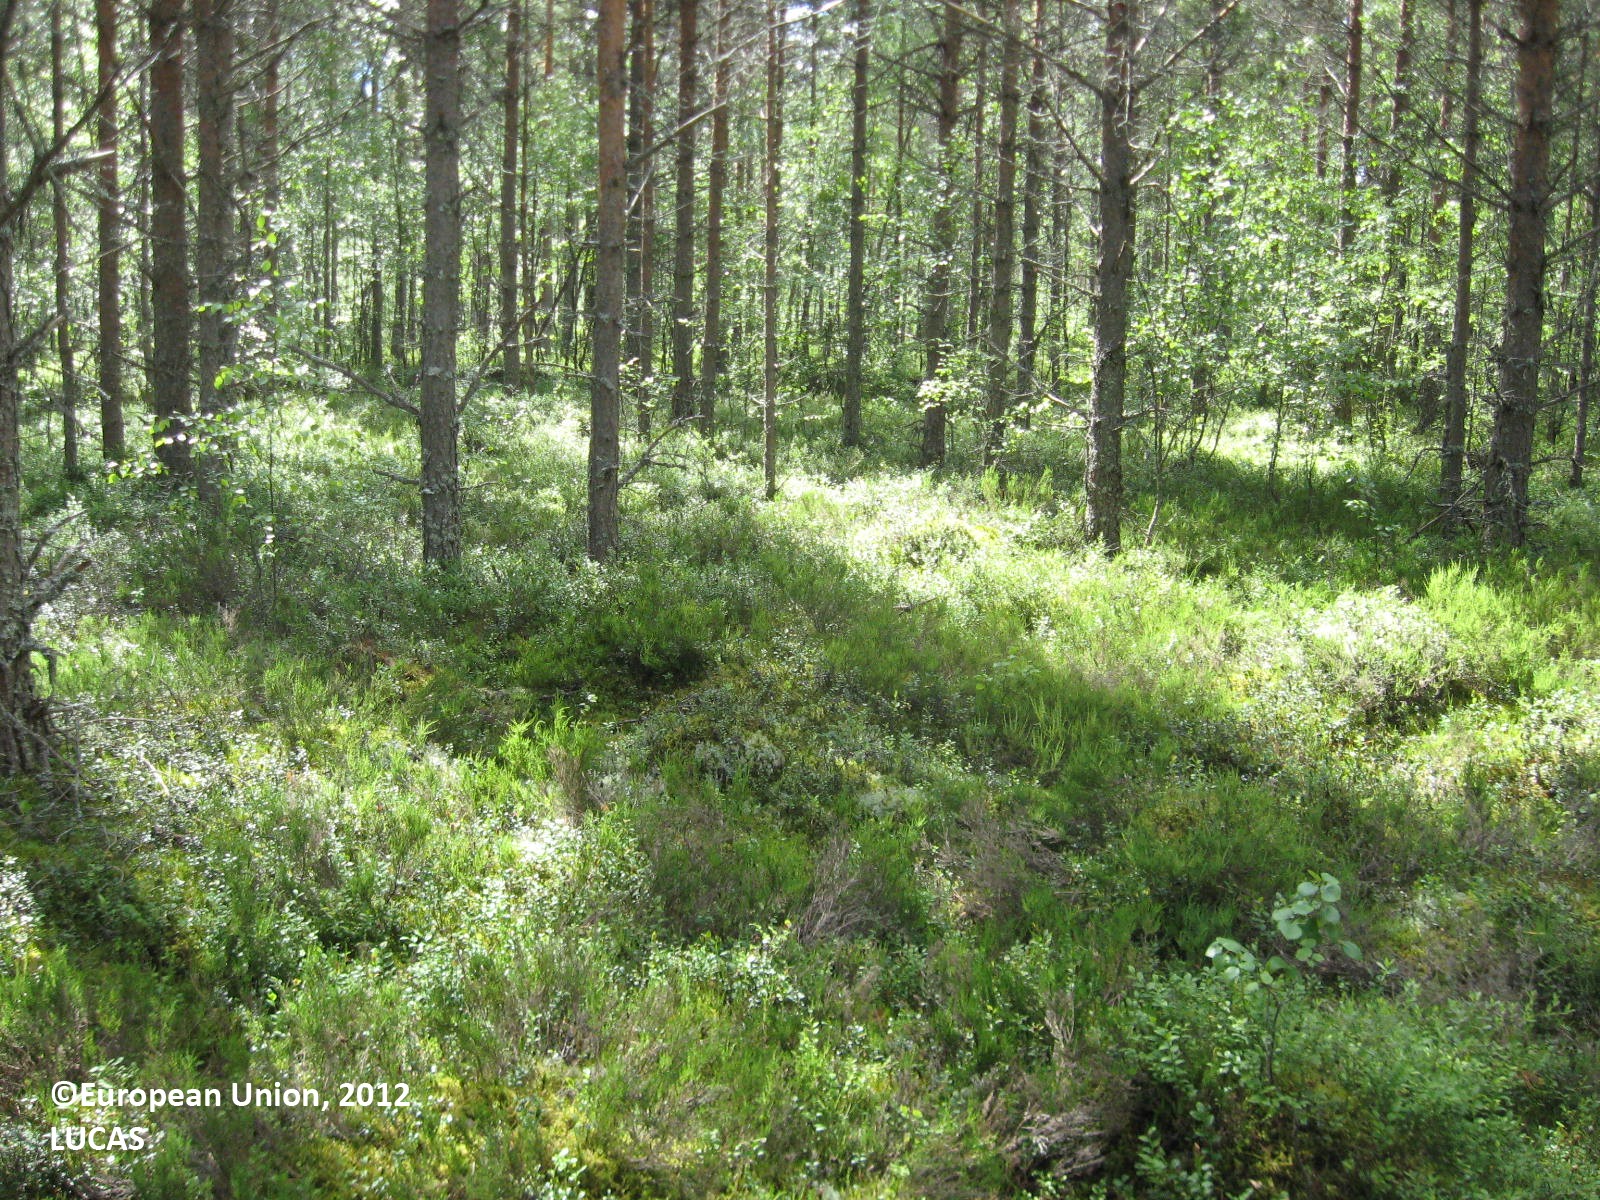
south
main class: Woodland
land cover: Pine dominated coniferous woodland
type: boreal forest
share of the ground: > 75 %
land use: Forestry
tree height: > 5 m
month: July
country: FI
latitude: 62.3037
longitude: 22.3403
